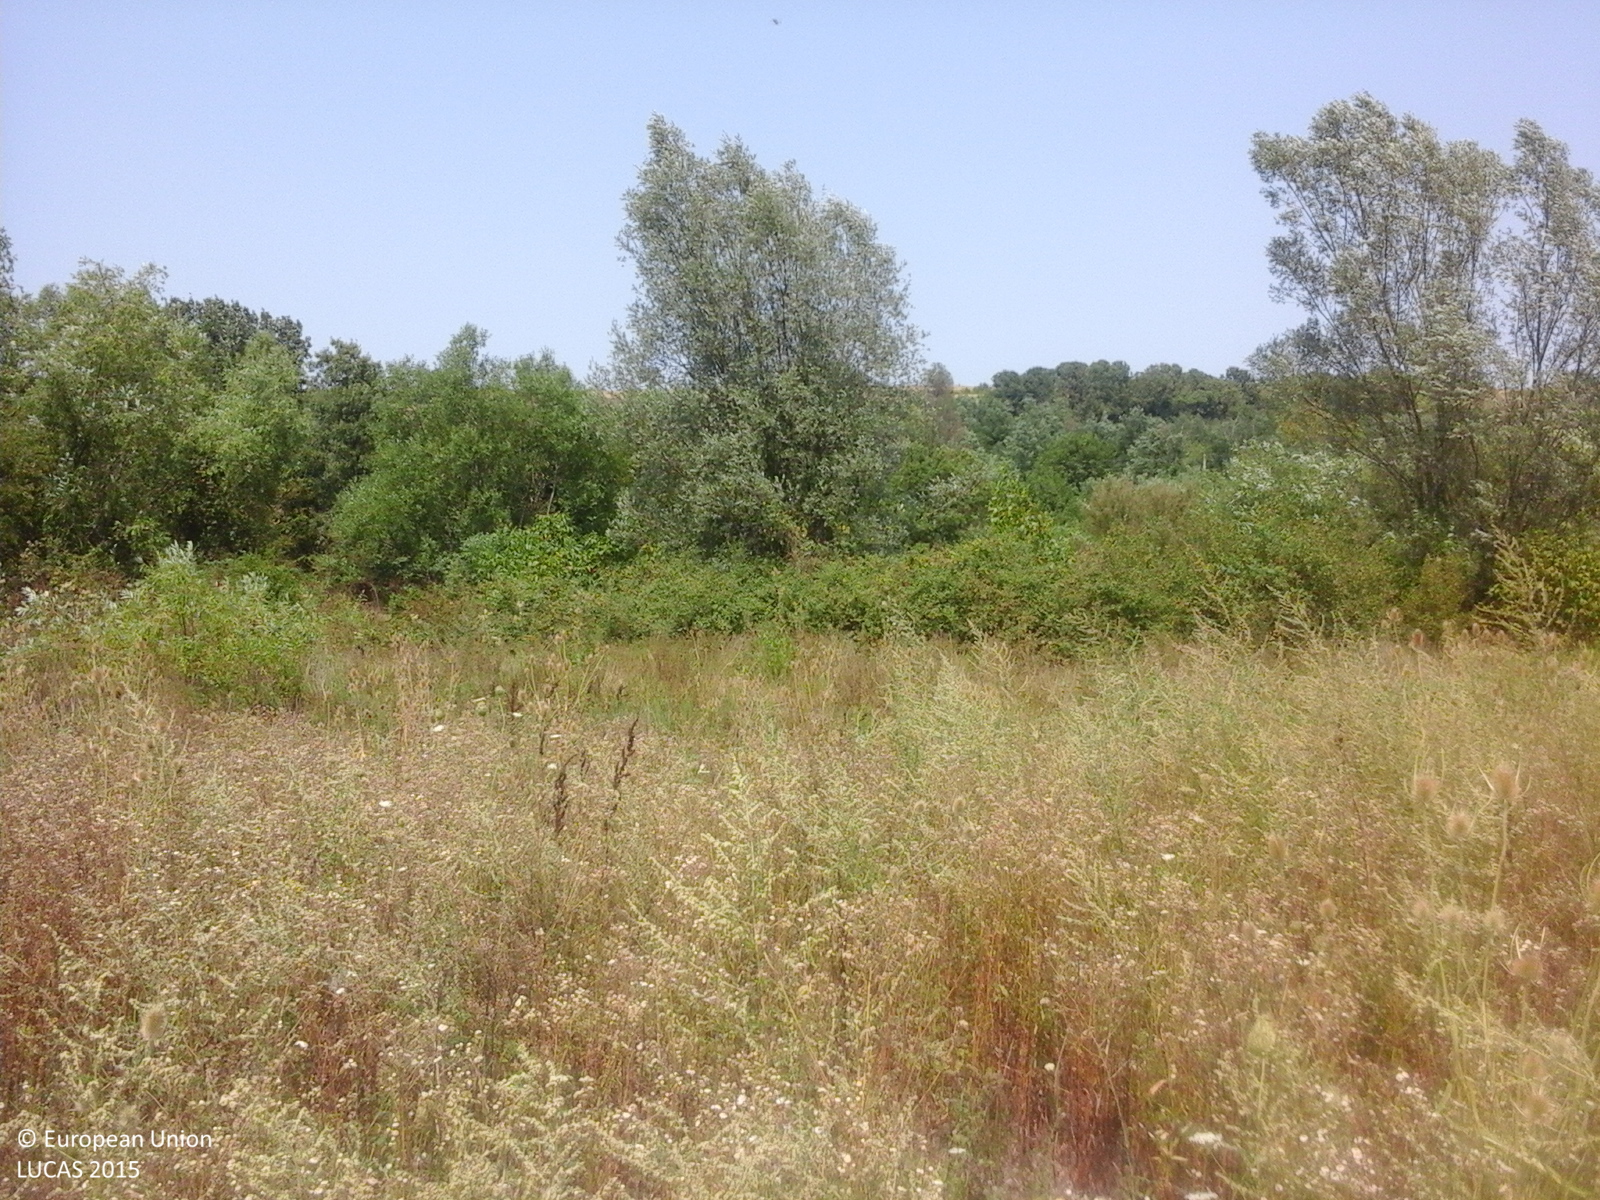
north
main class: Grassland
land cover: Spontaneously vegetated surfaces
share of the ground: > 75 %
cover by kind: herbaceous plants 100 %
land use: Fallow land
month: August
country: RO
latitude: 44.3971
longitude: 23.3456
